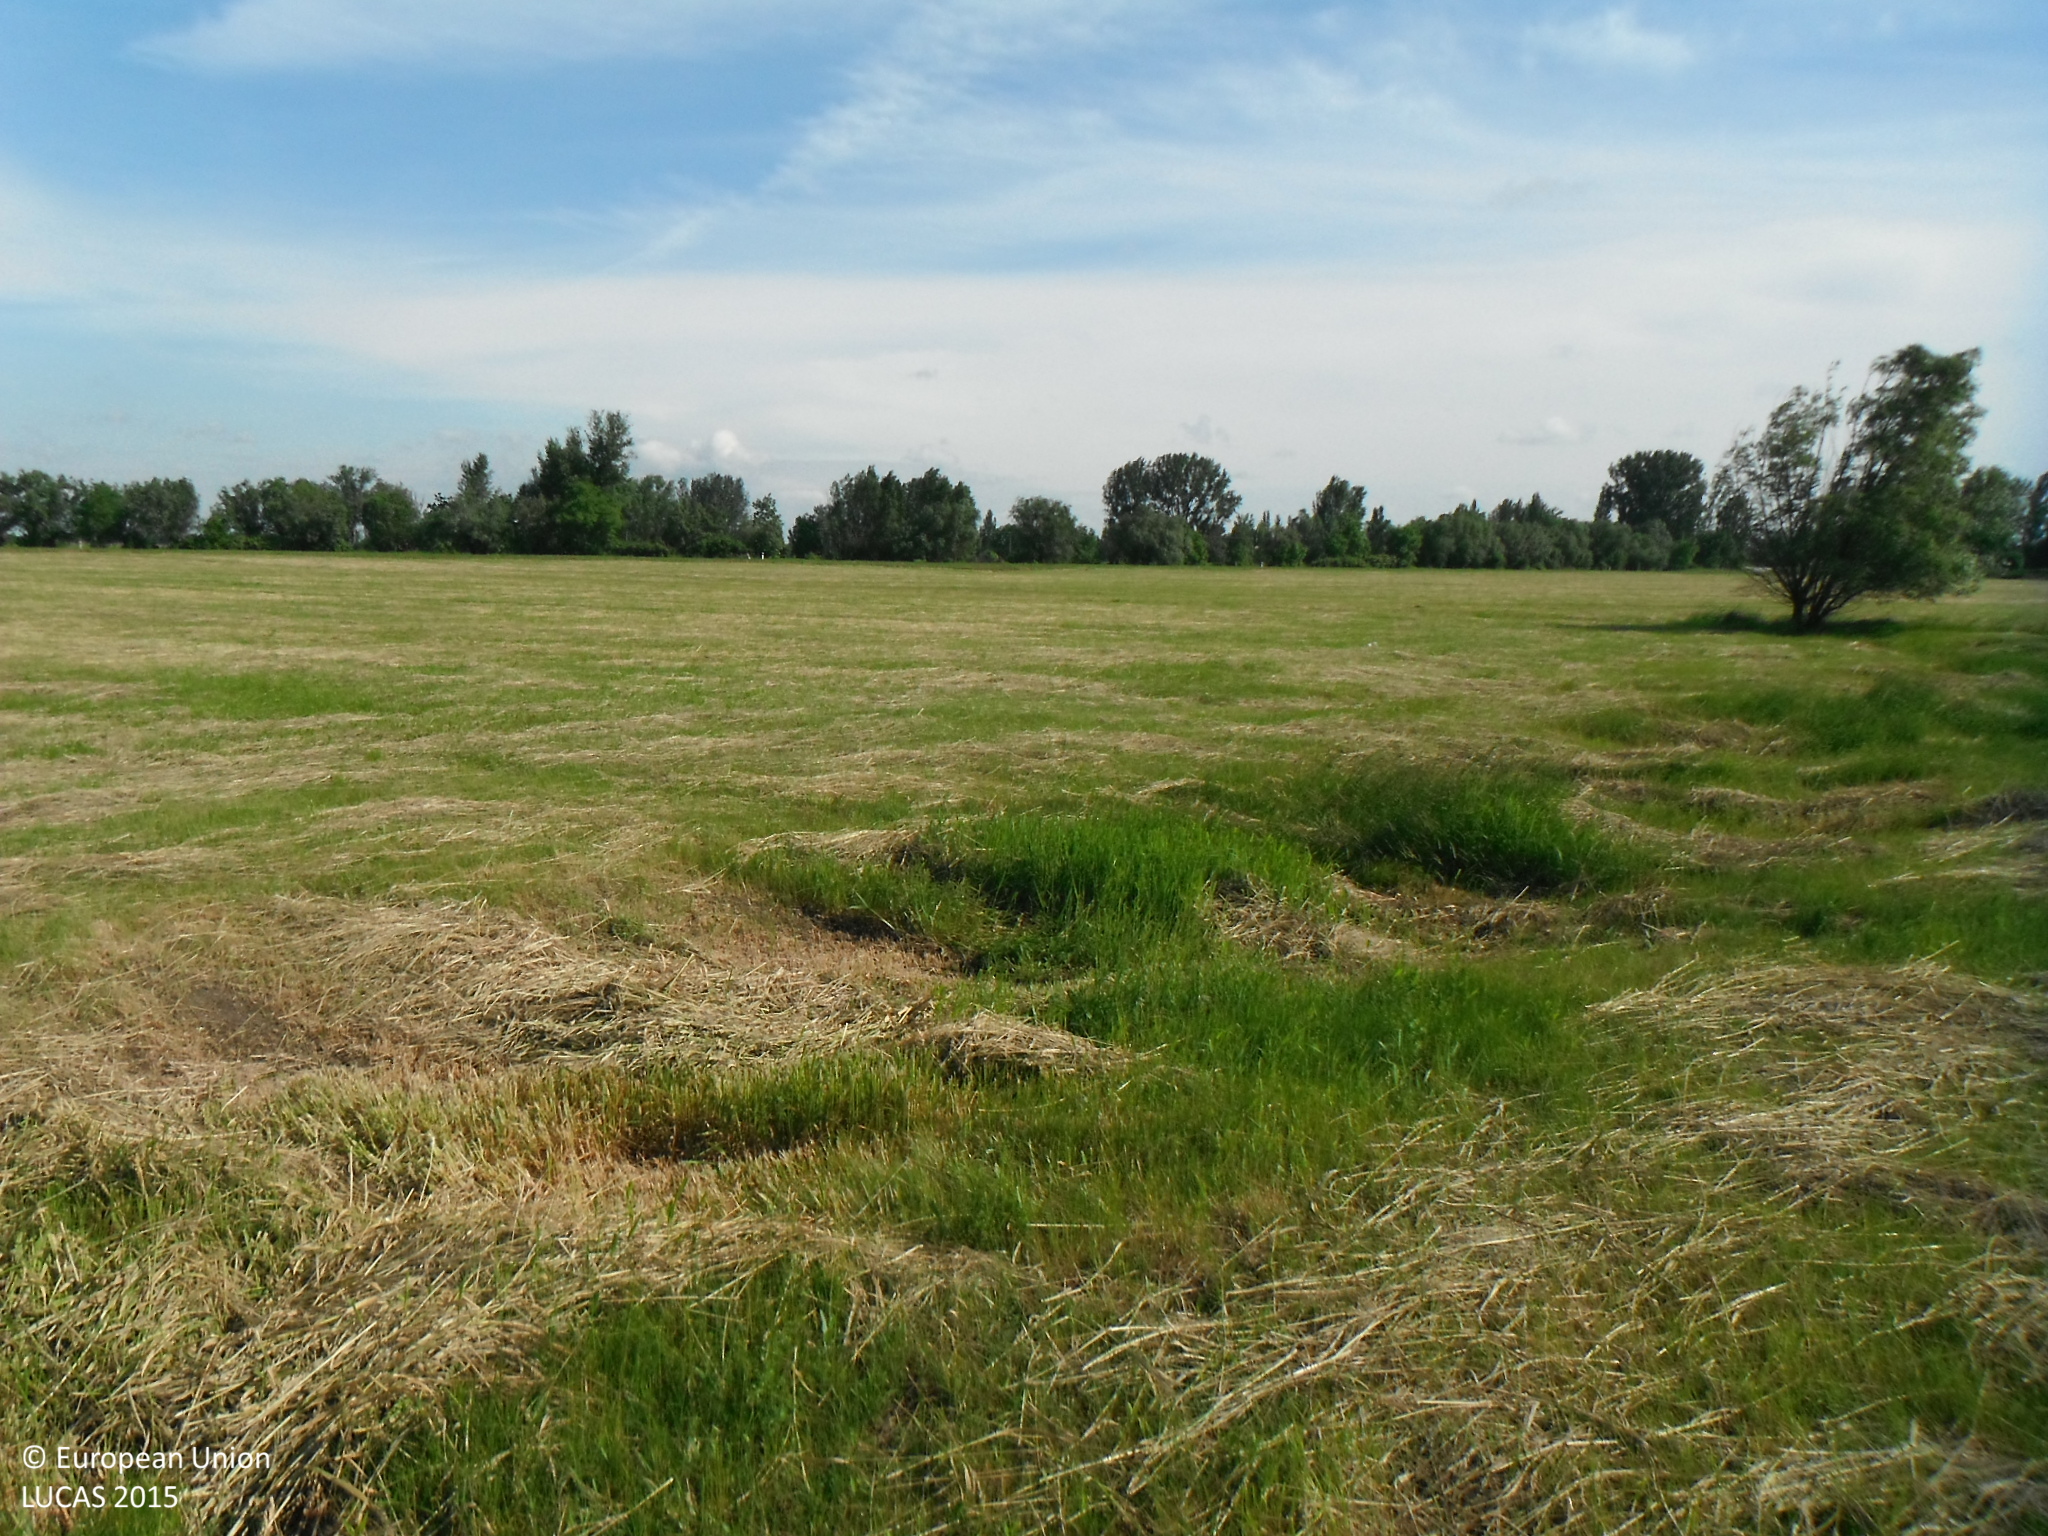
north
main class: Grassland
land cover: Grassland without tree/shrub cover
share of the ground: > 75 %
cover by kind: herbaceous plants 100 %
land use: Agriculture (excluding fallow land and kitchen gardens)
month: May
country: SK
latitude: 47.7905
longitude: 17.7123
